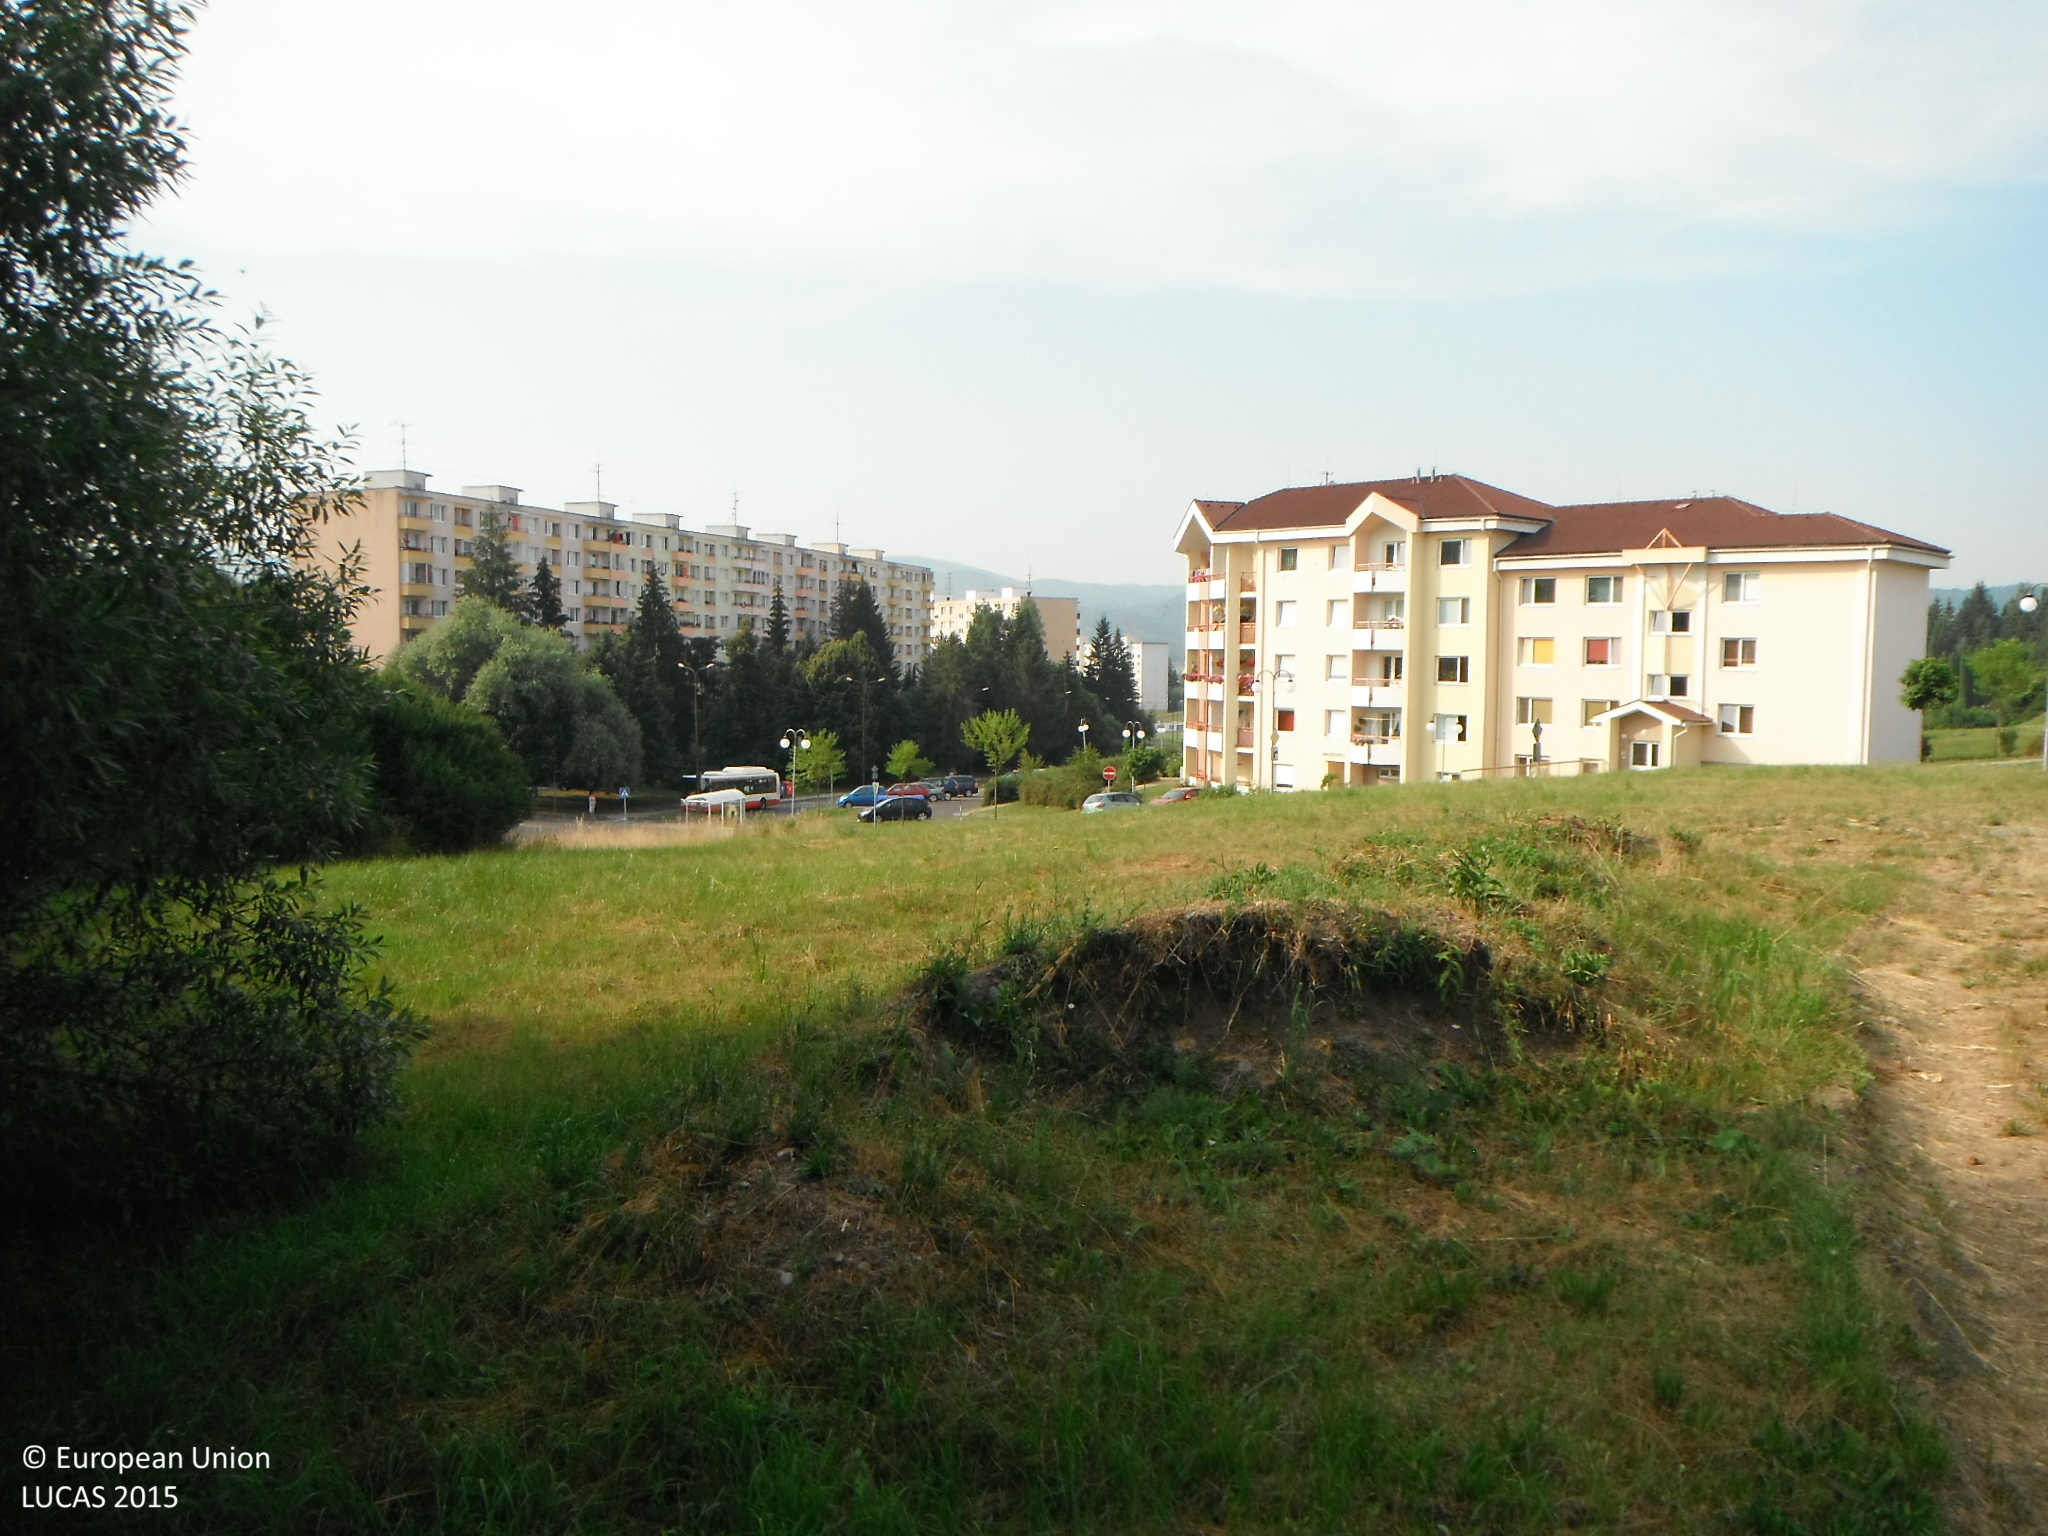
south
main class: Grassland
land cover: Grassland without tree/shrub cover
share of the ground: > 75 %
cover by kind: herbaceous plants 100 %
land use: Agriculture (excluding fallow land and kitchen gardens)
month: July
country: SK
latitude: 48.5851
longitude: 19.1455
